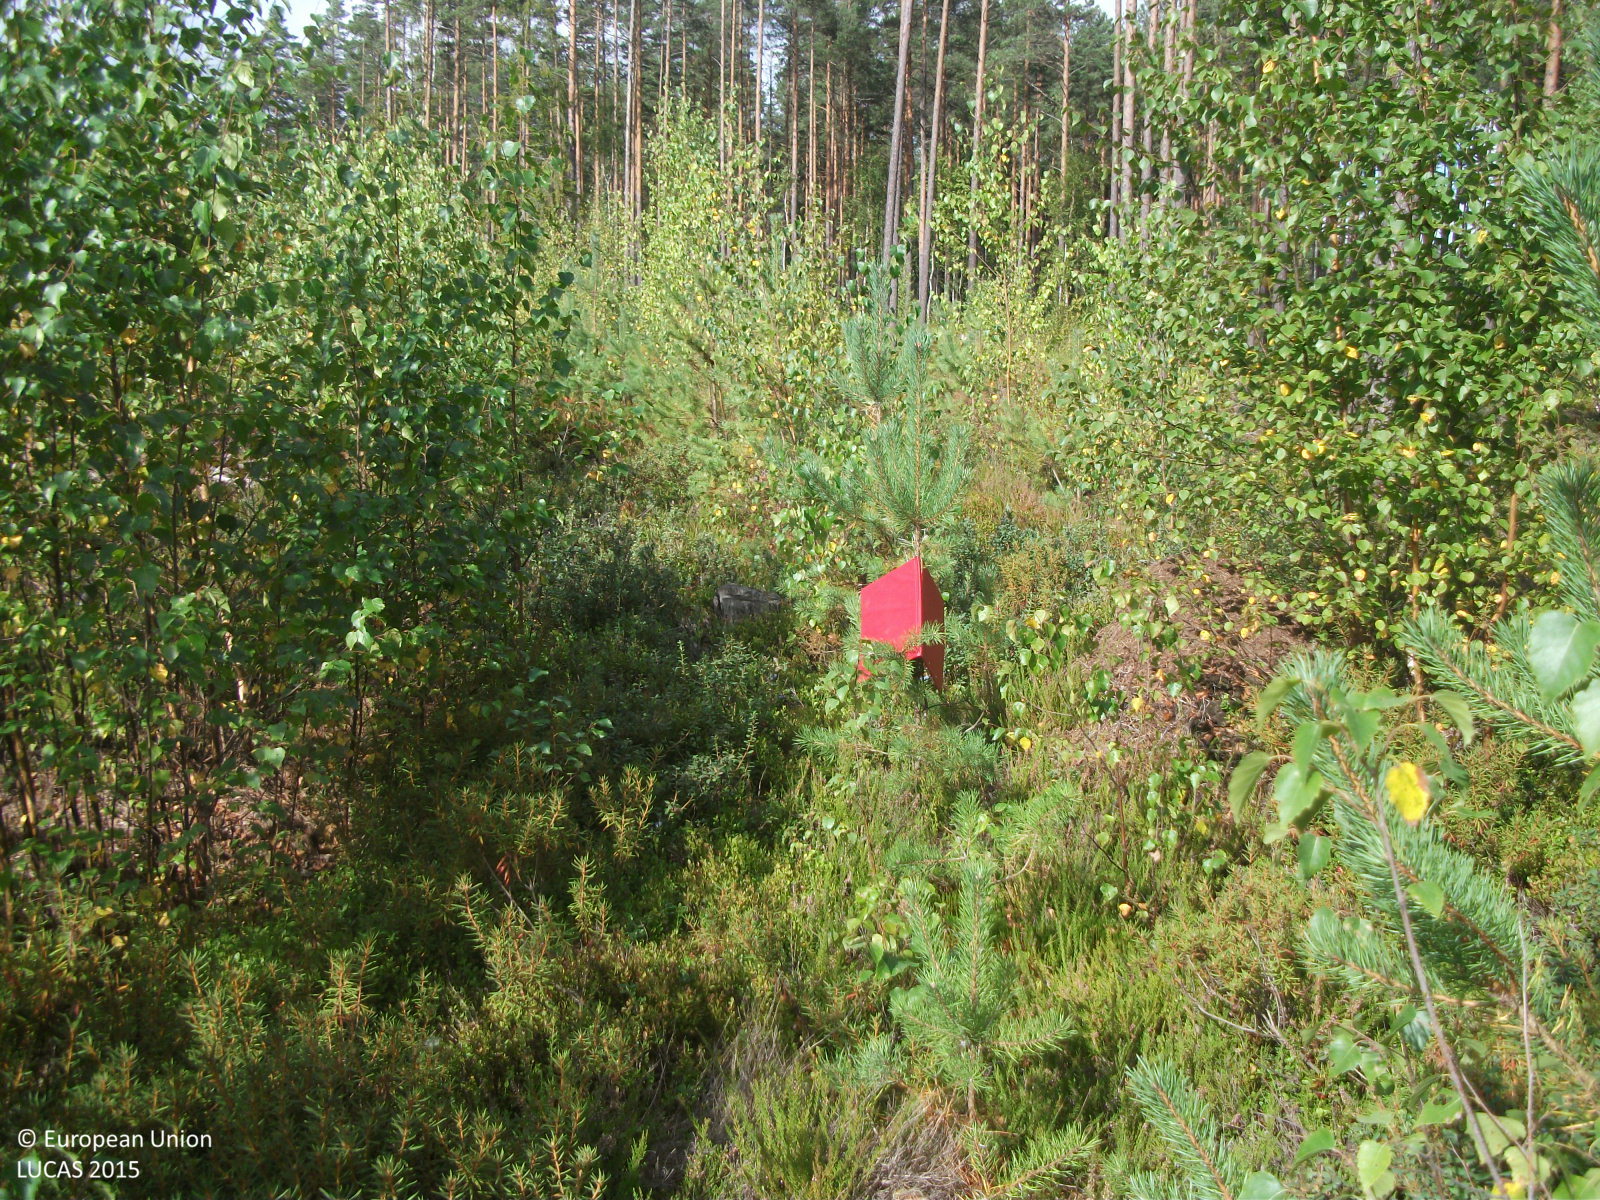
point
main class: Woodland
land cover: Other mixed woodland
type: hemiboreal forest and nemoral coniferous forest and mixed broadleaved-coniferous forest
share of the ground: 50 - 75 %
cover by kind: broadleaved forest trees 45 %, coniferous forest trees 25 %, shrubs 15 %, herbaceous plants 10 %, lichens and mosses 5 %
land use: Forestry
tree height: < 5 m
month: September
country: LV
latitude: 56.5774
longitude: 26.2394
